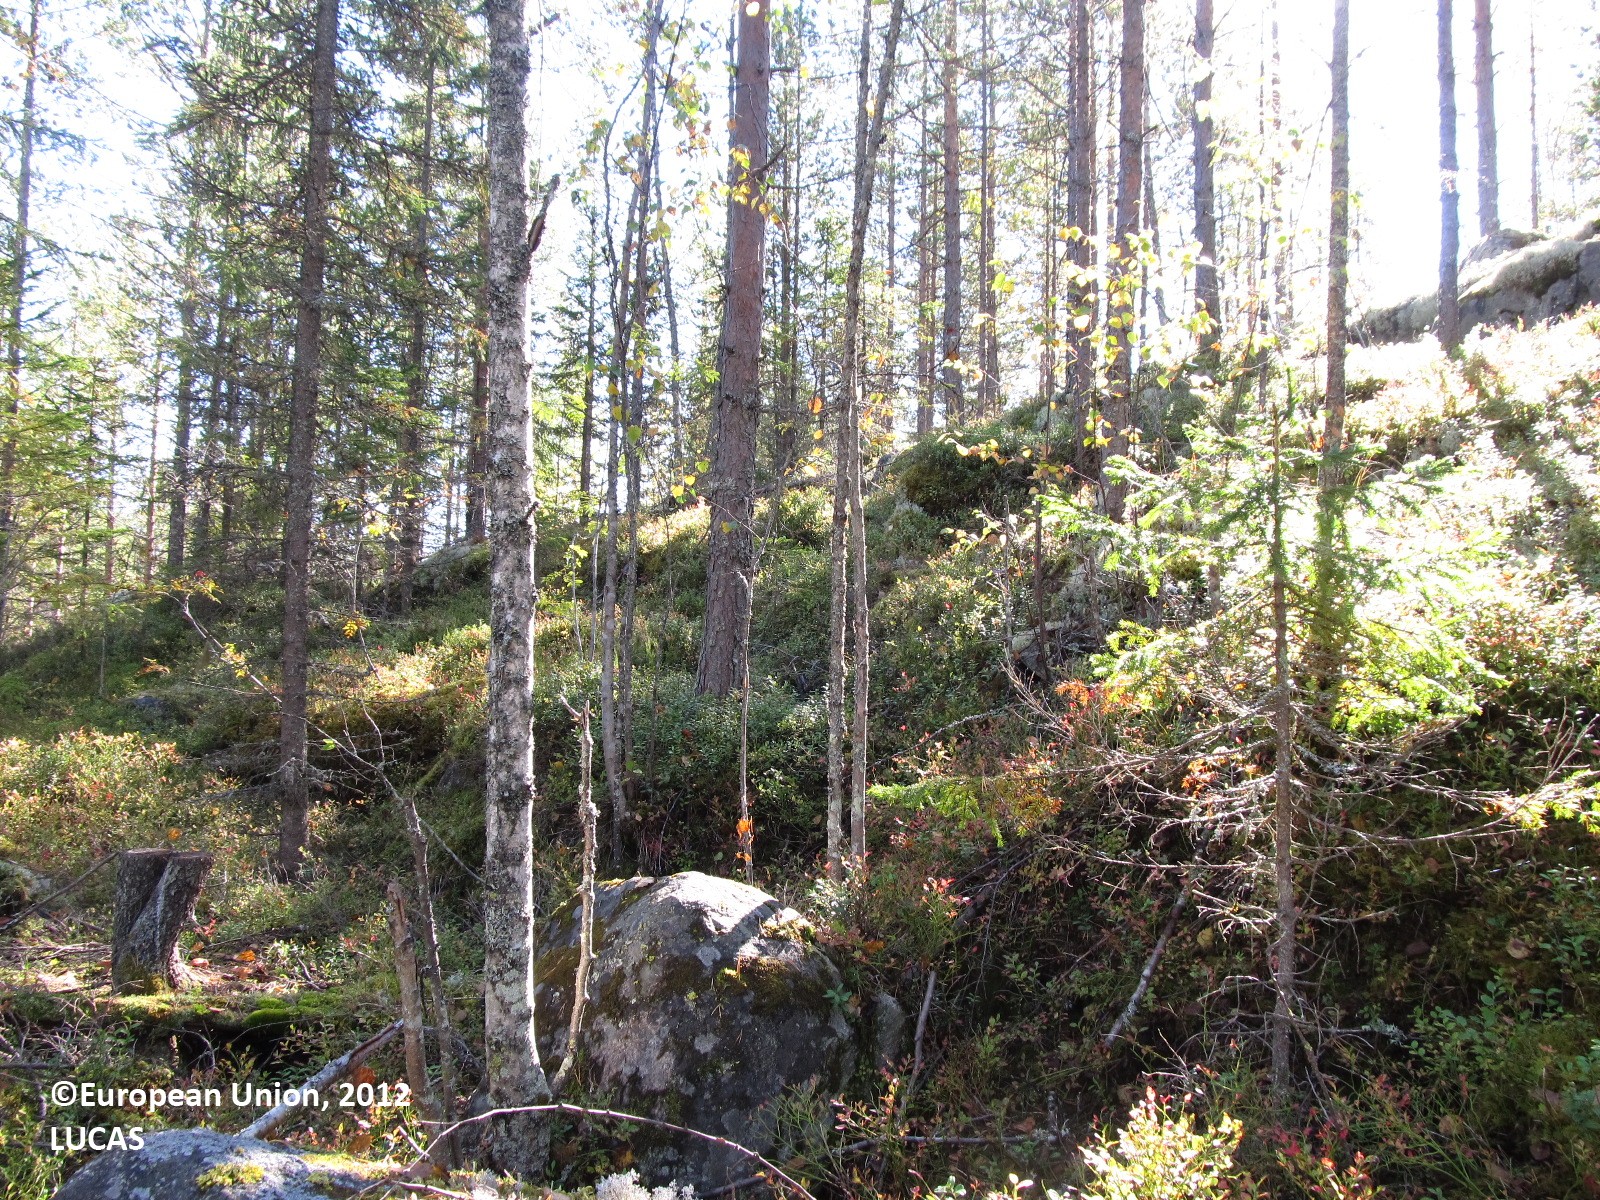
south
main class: Woodland
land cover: Other coniferous woodland
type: boreal forest
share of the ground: 50 - 75 %
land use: Forestry
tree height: > 5 m
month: September
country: FI
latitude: 62.4478
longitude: 28.5554
